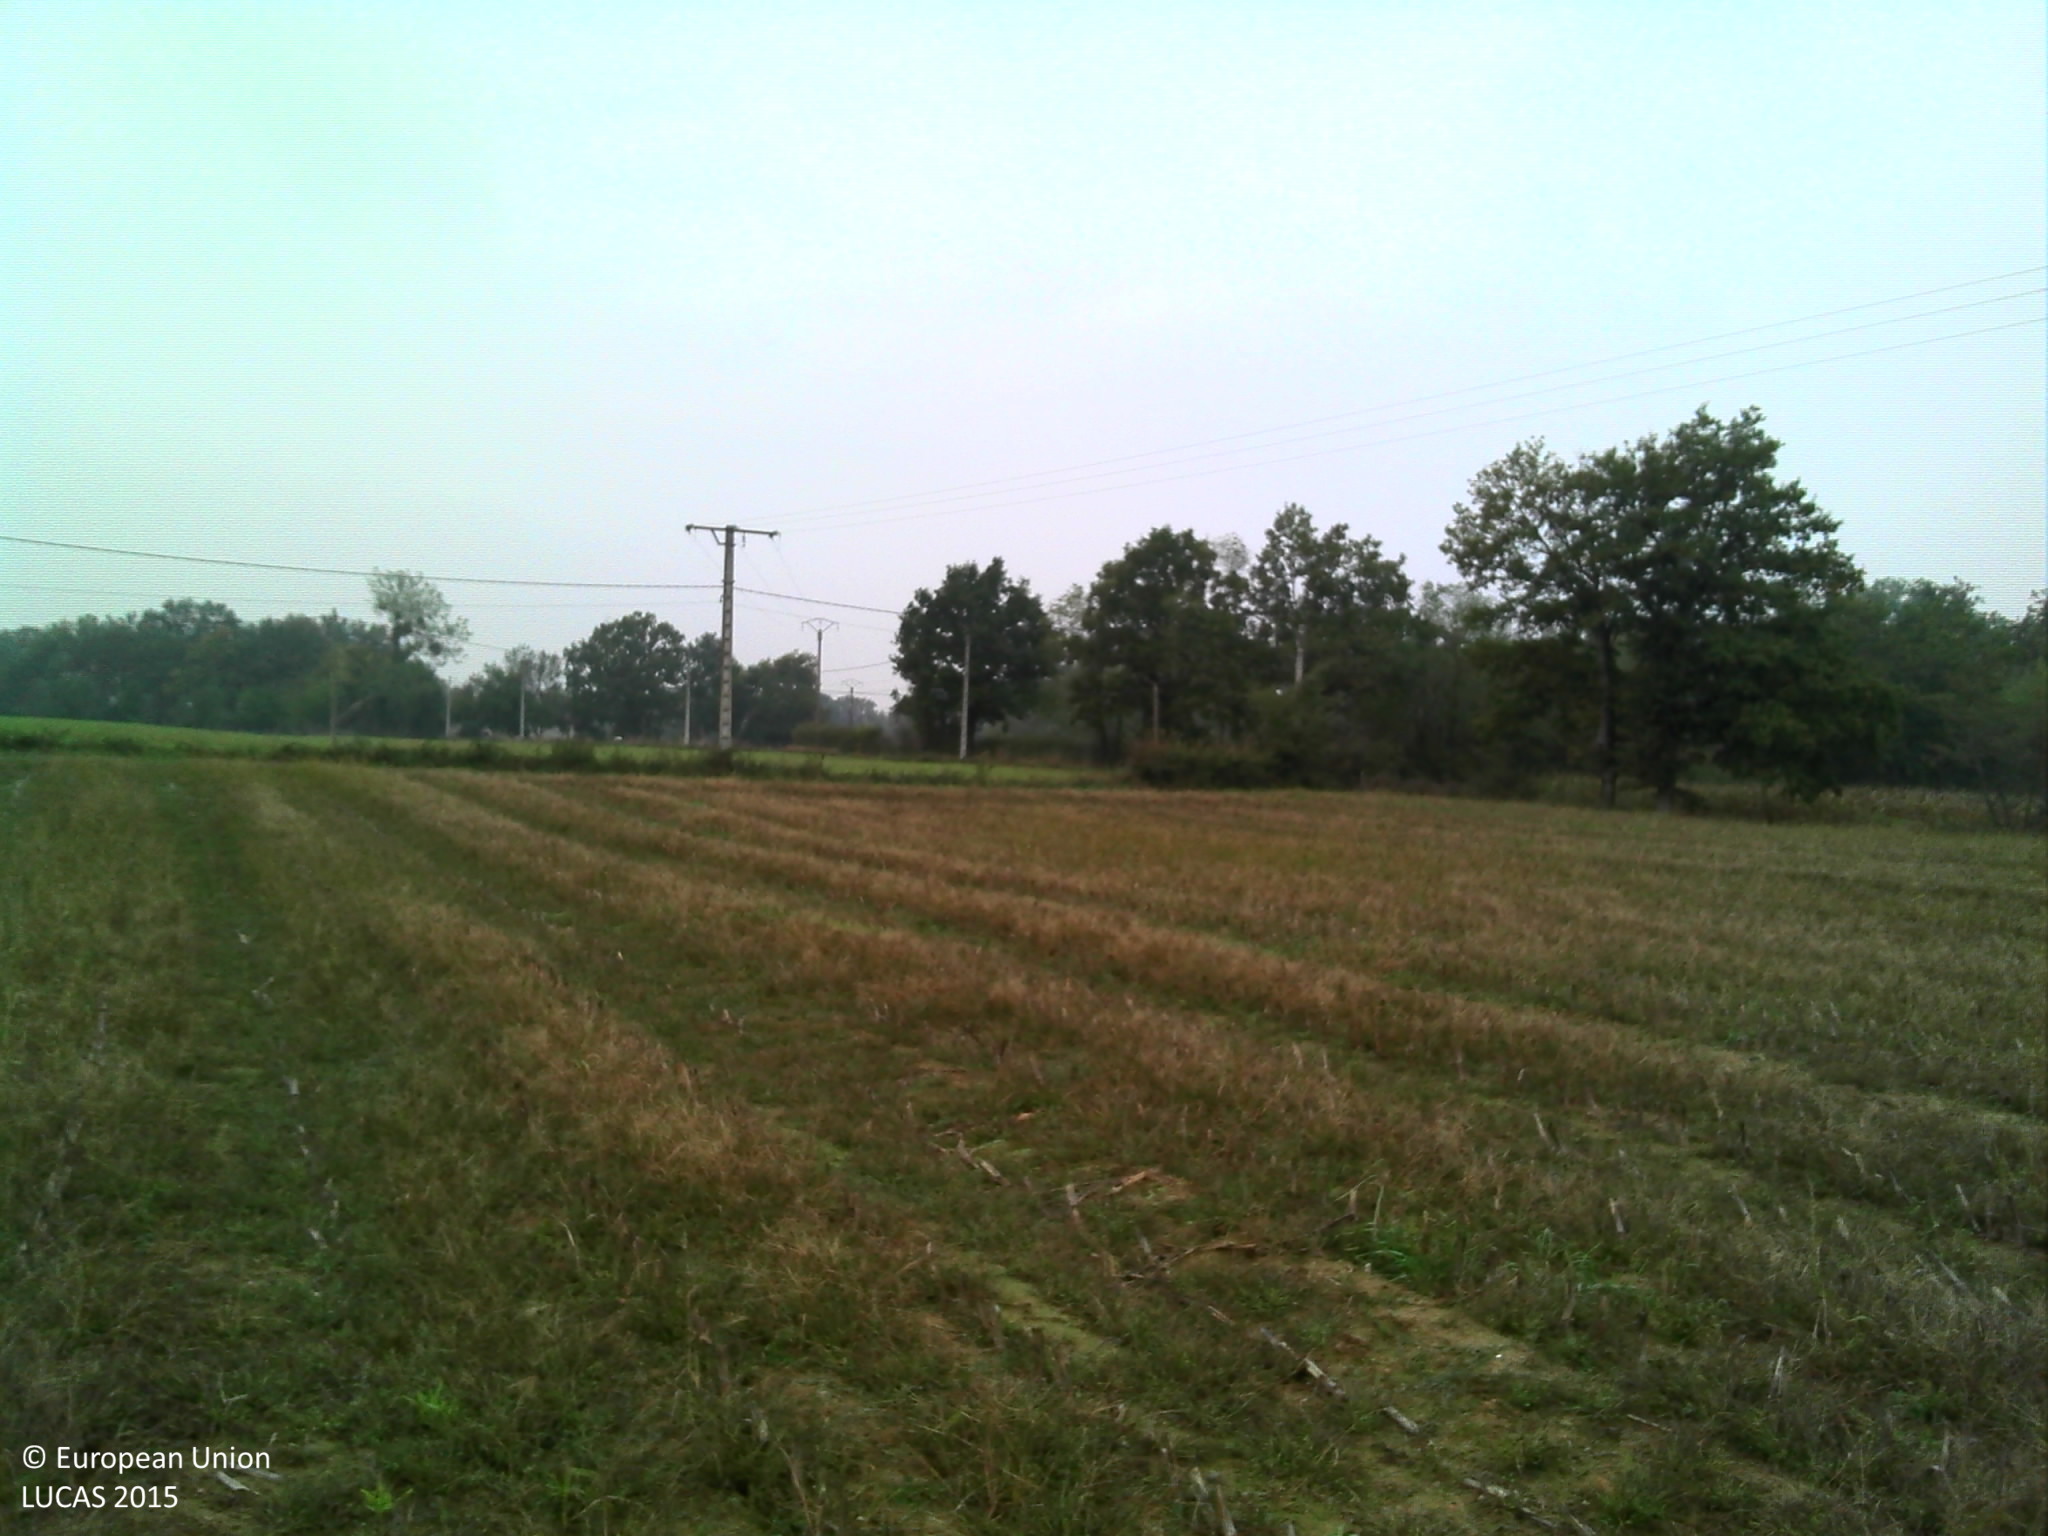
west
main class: Cropland
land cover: Maize
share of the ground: < 10 %
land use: Agriculture (excluding fallow land and kitchen gardens)
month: October
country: FR
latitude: 46.2947
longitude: 5.1346
